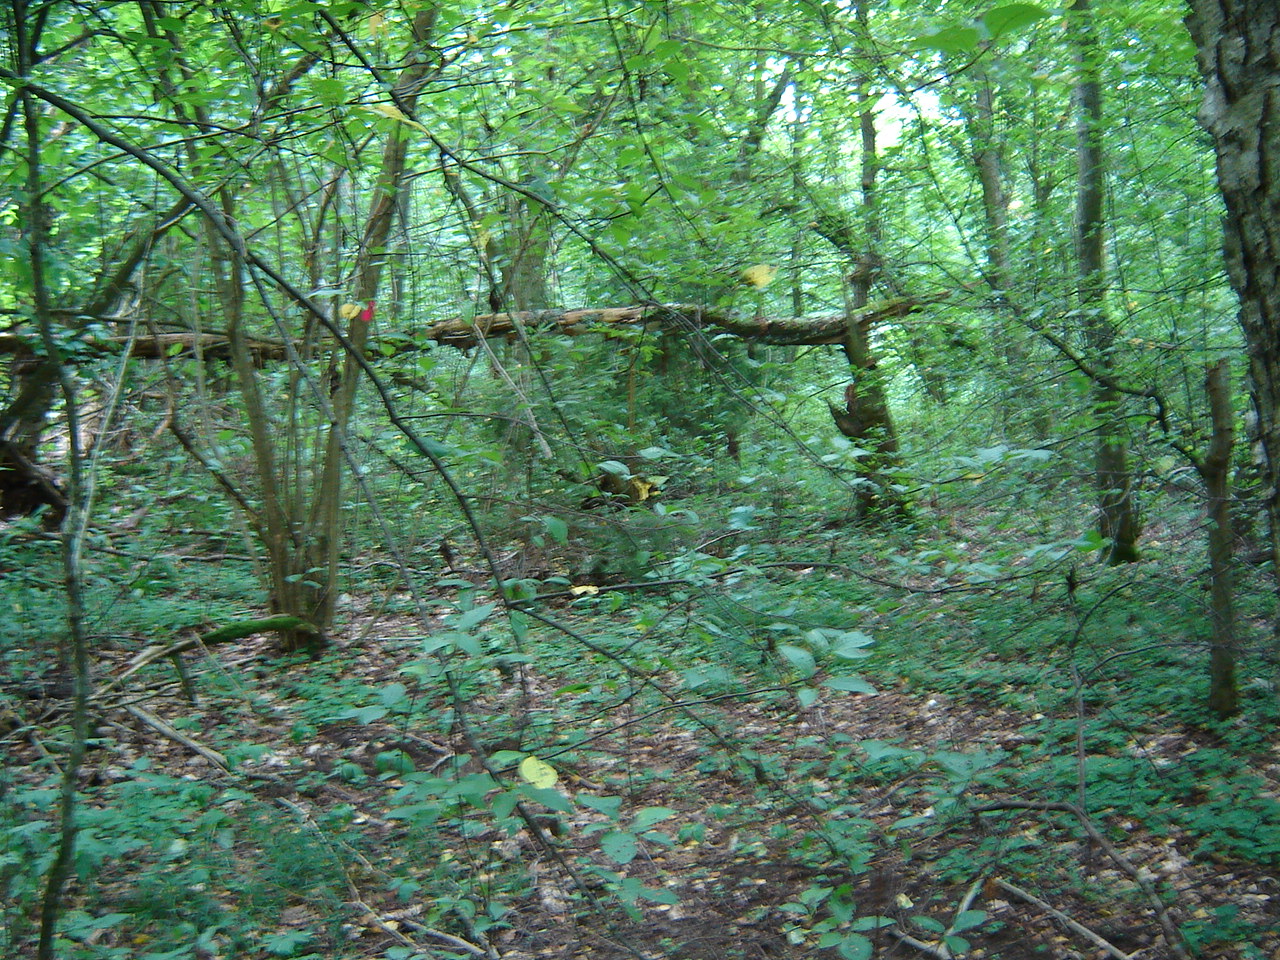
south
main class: Woodland
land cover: Other mixed woodland
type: hemiboreal forest and nemoral coniferous forest and mixed broadleaved-coniferous forest
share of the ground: > 75 %
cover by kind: broadleaved forest trees 50 %, coniferous forest trees 45 %, herbaceous plants 5 %
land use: Forestry
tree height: > 5 m
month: July
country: LT
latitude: 55.3129
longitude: 25.0342
